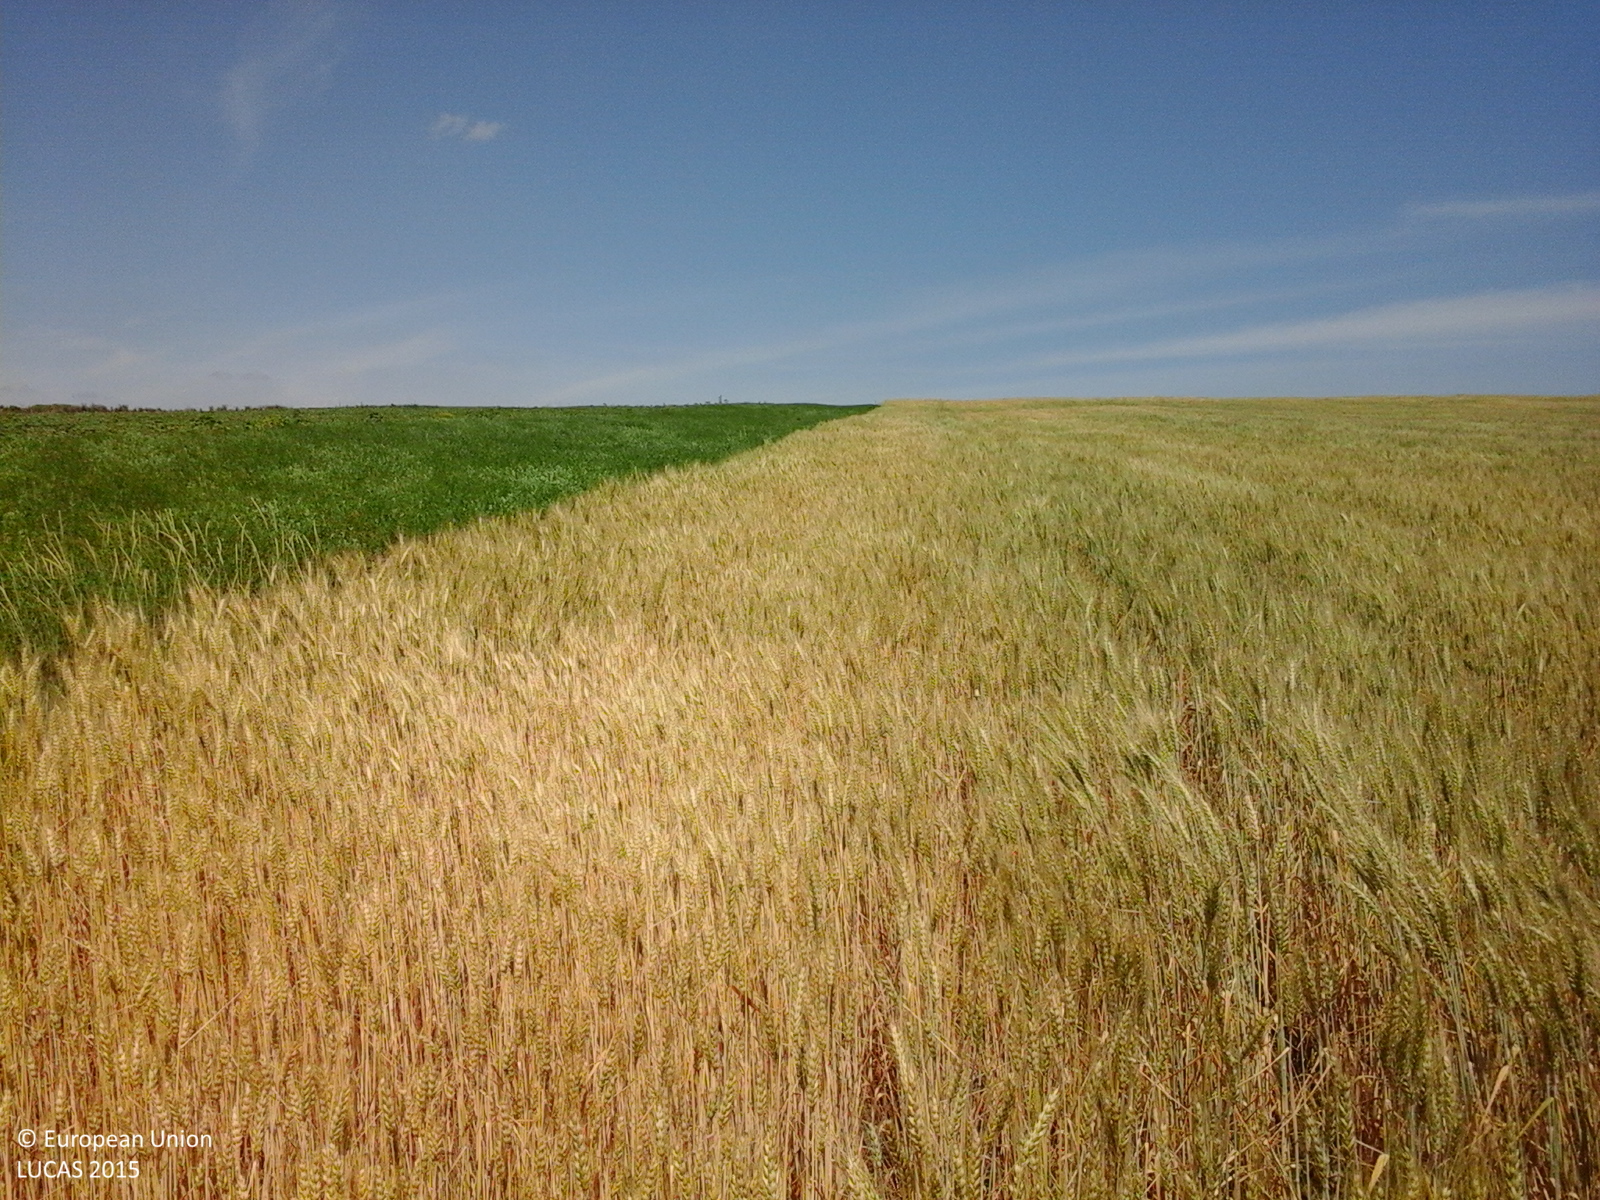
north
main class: Cropland
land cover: Common wheat
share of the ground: > 75 %
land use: Agriculture (excluding fallow land and kitchen gardens)
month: June
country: RO
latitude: 48.1096
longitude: 26.9619
